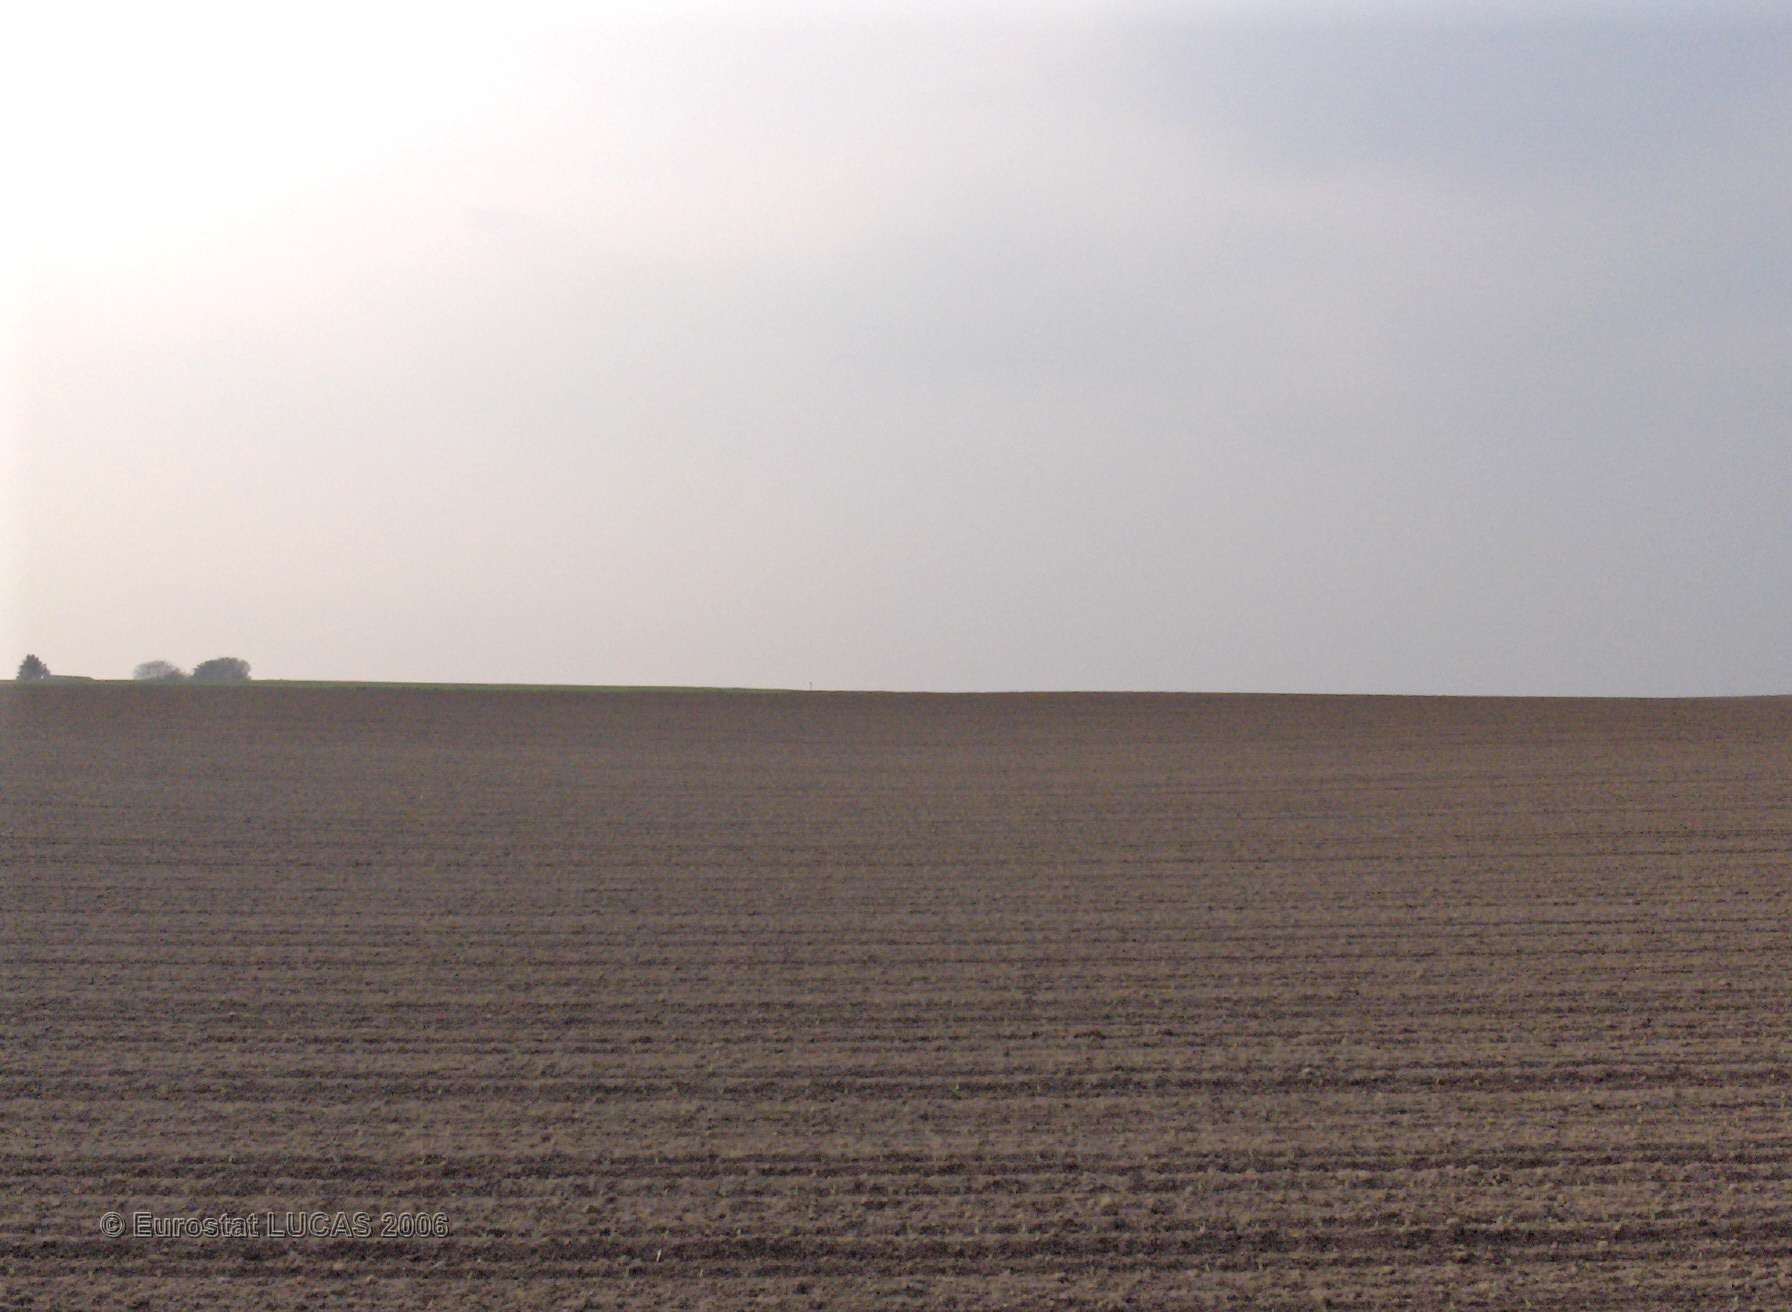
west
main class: Cropland
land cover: Sugar beet
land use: Agriculture (excluding fallow land and kitchen gardens)
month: May
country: BE
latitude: 50.6832
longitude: 4.5185
